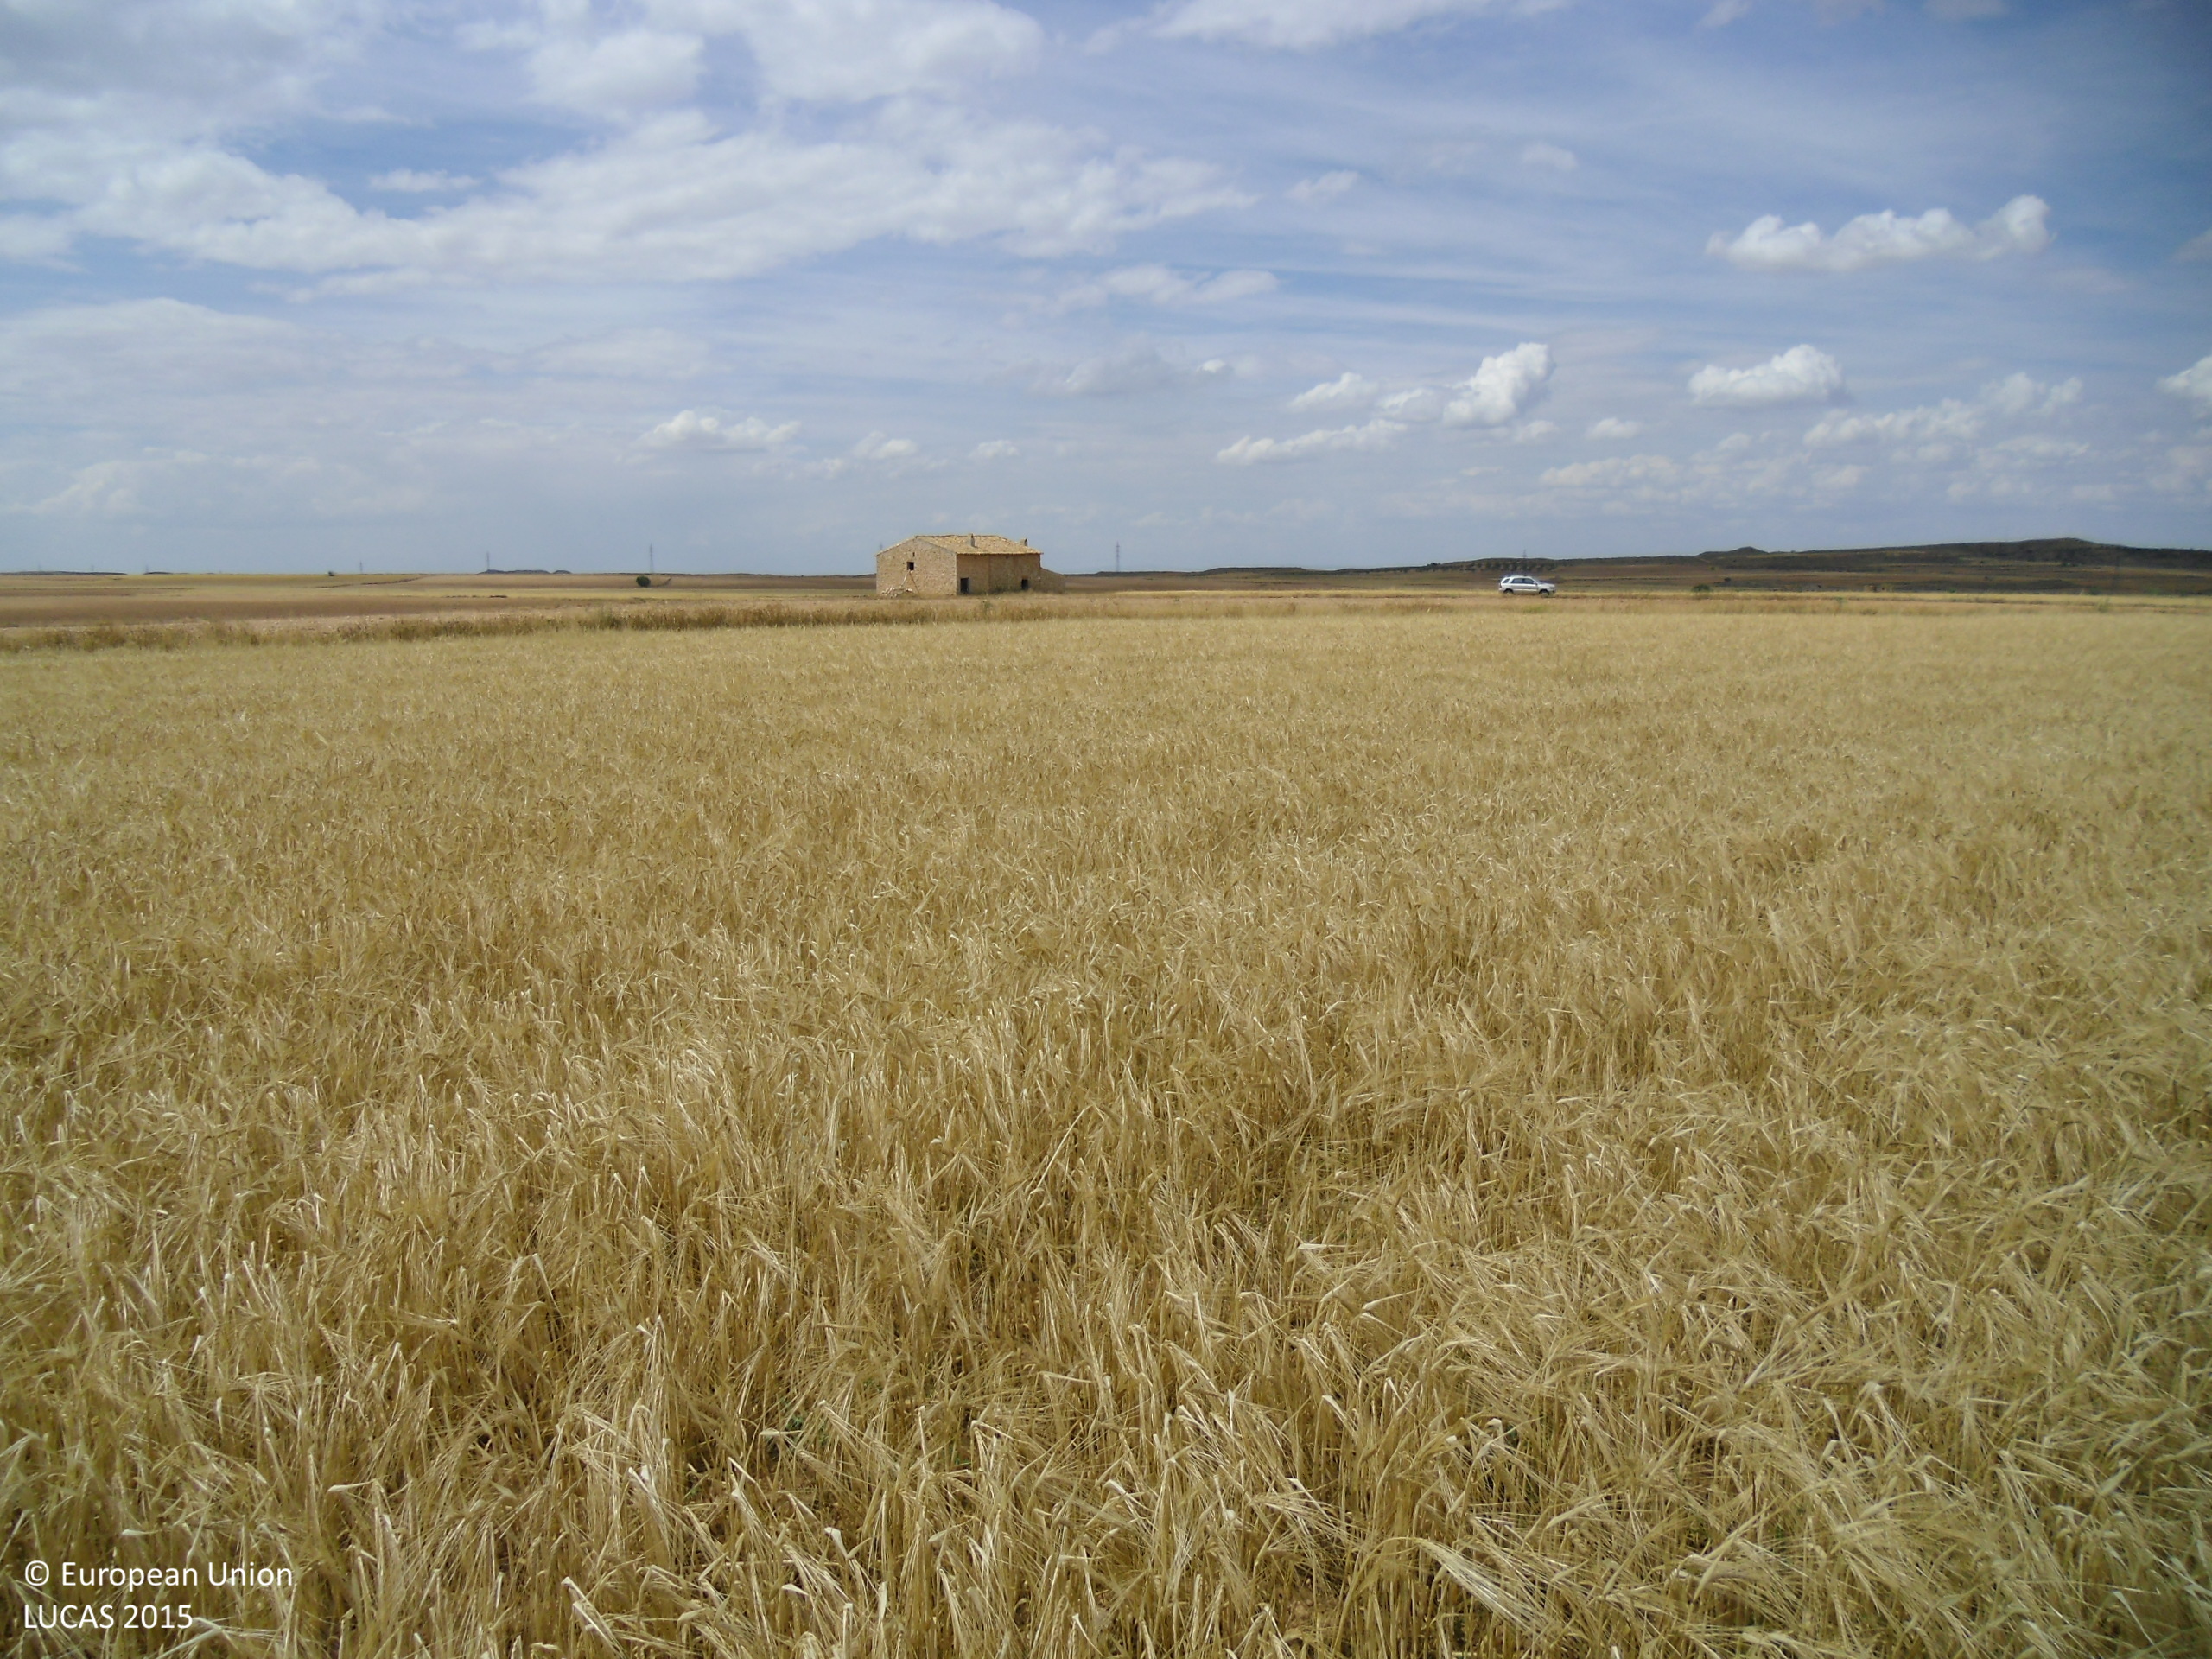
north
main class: Cropland
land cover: Rye
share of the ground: > 75 %
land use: Agriculture (excluding fallow land and kitchen gardens)
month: June
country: ES
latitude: 41.1224
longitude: -0.3397
